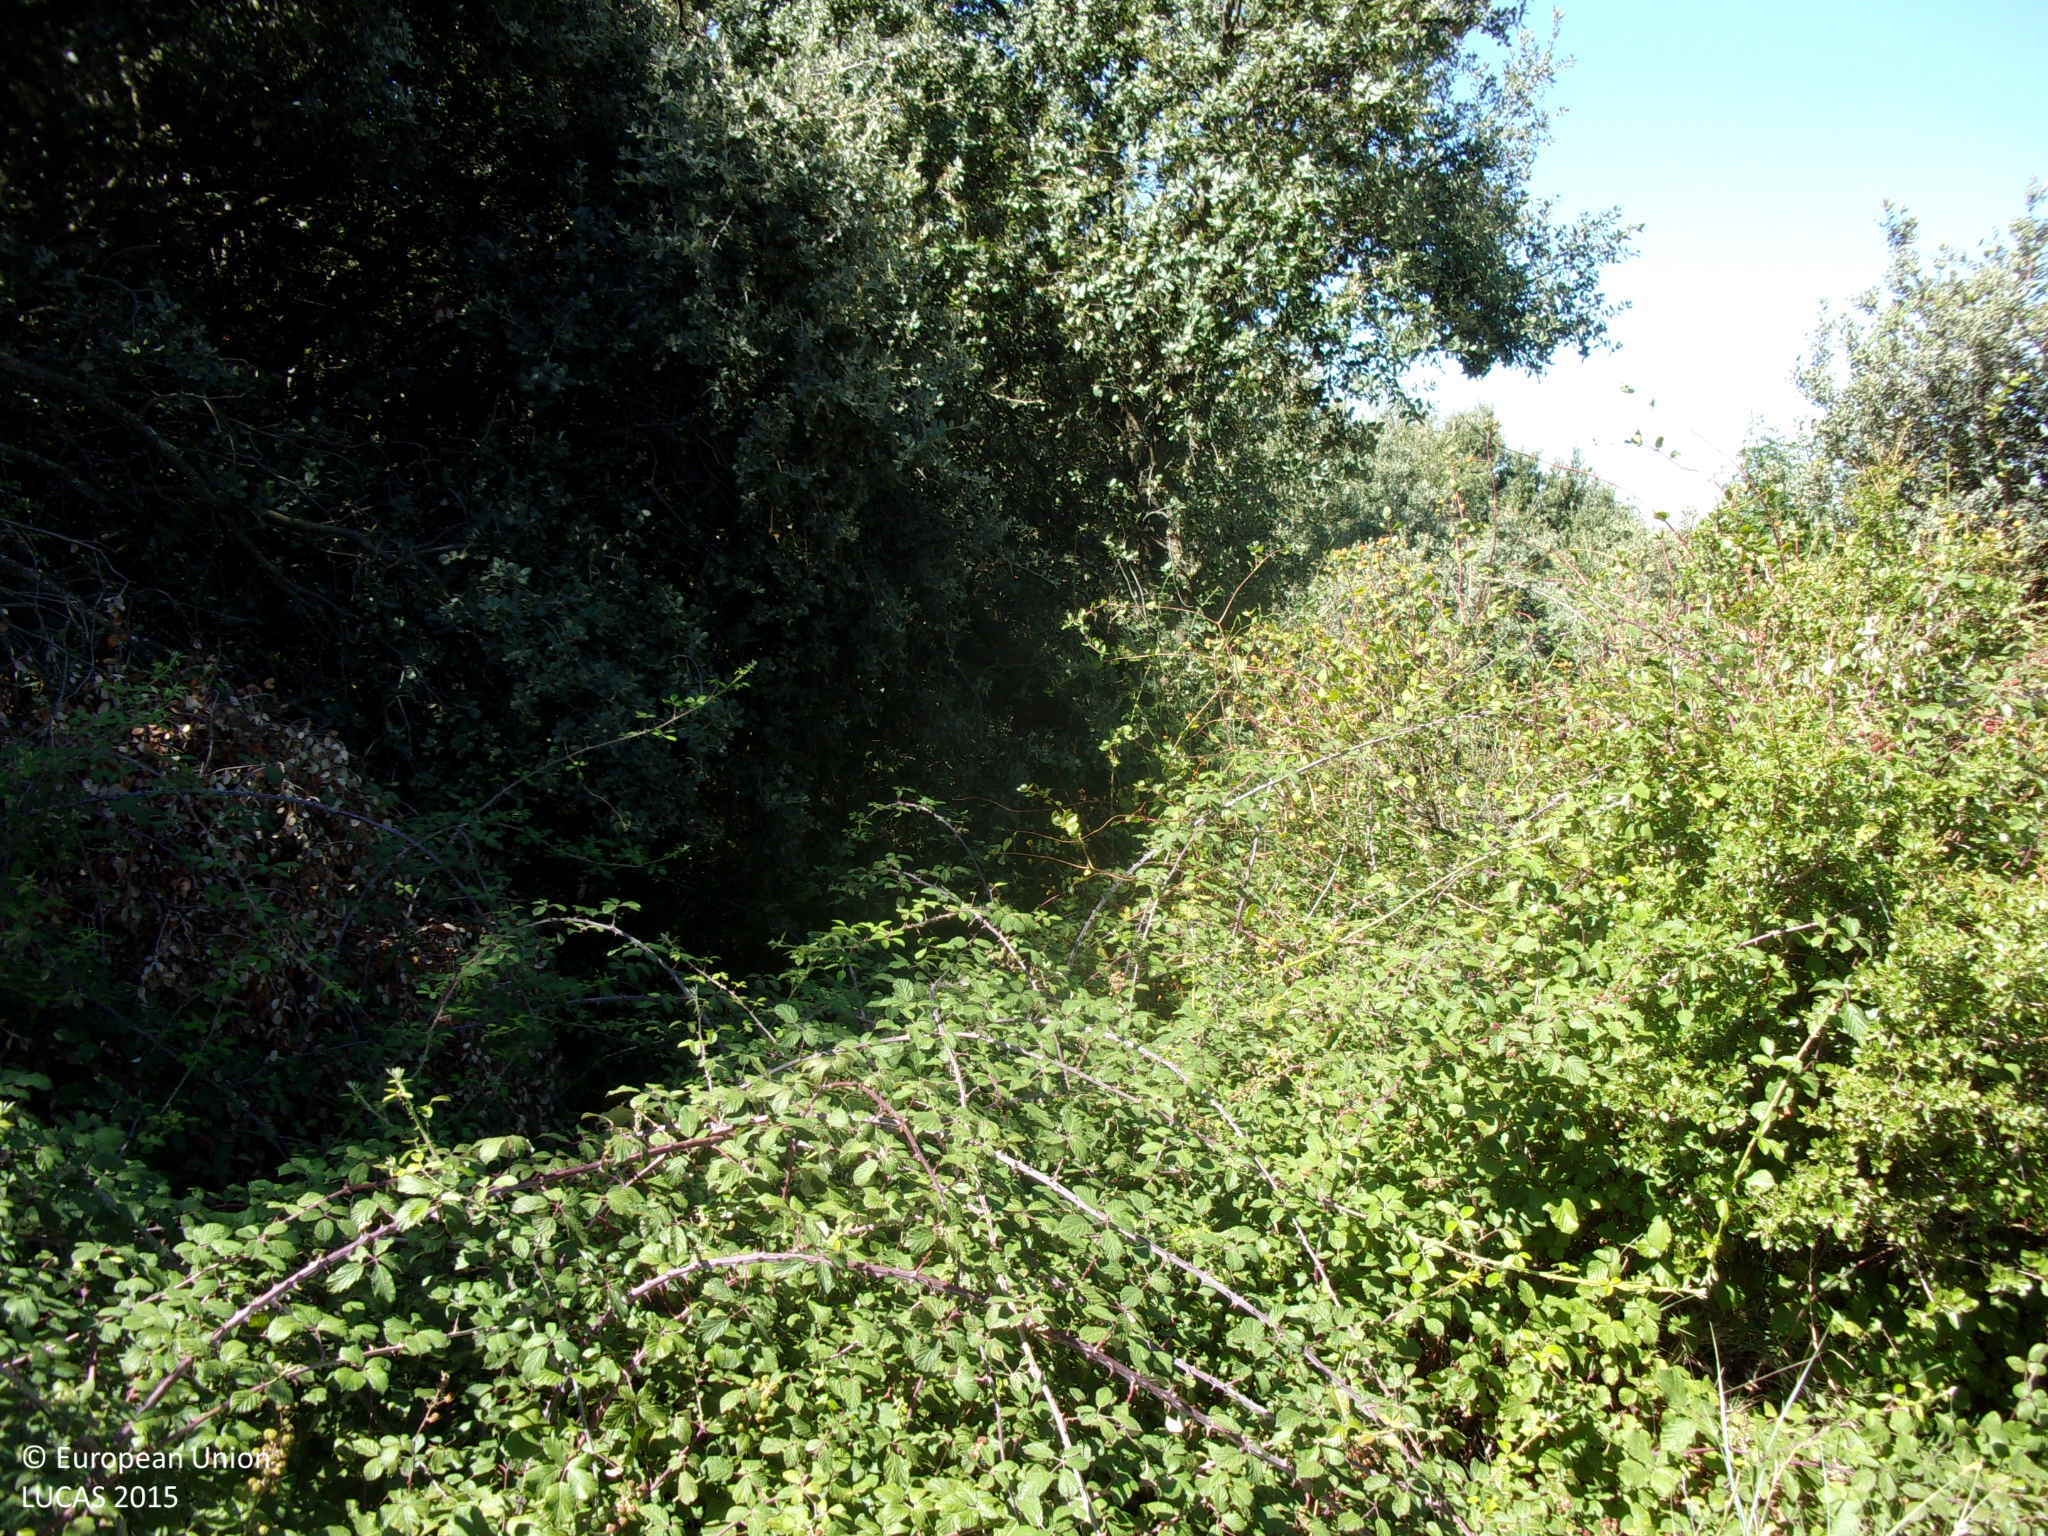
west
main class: Woodland
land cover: Broadleaved woodland
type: thermophilous deciduous forest
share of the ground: > 75 %
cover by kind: broadleaved forest trees 90 %, shrubs 10 %
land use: Forestry
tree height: < 5 m
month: August
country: ES
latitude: 42.3805
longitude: -1.1680
